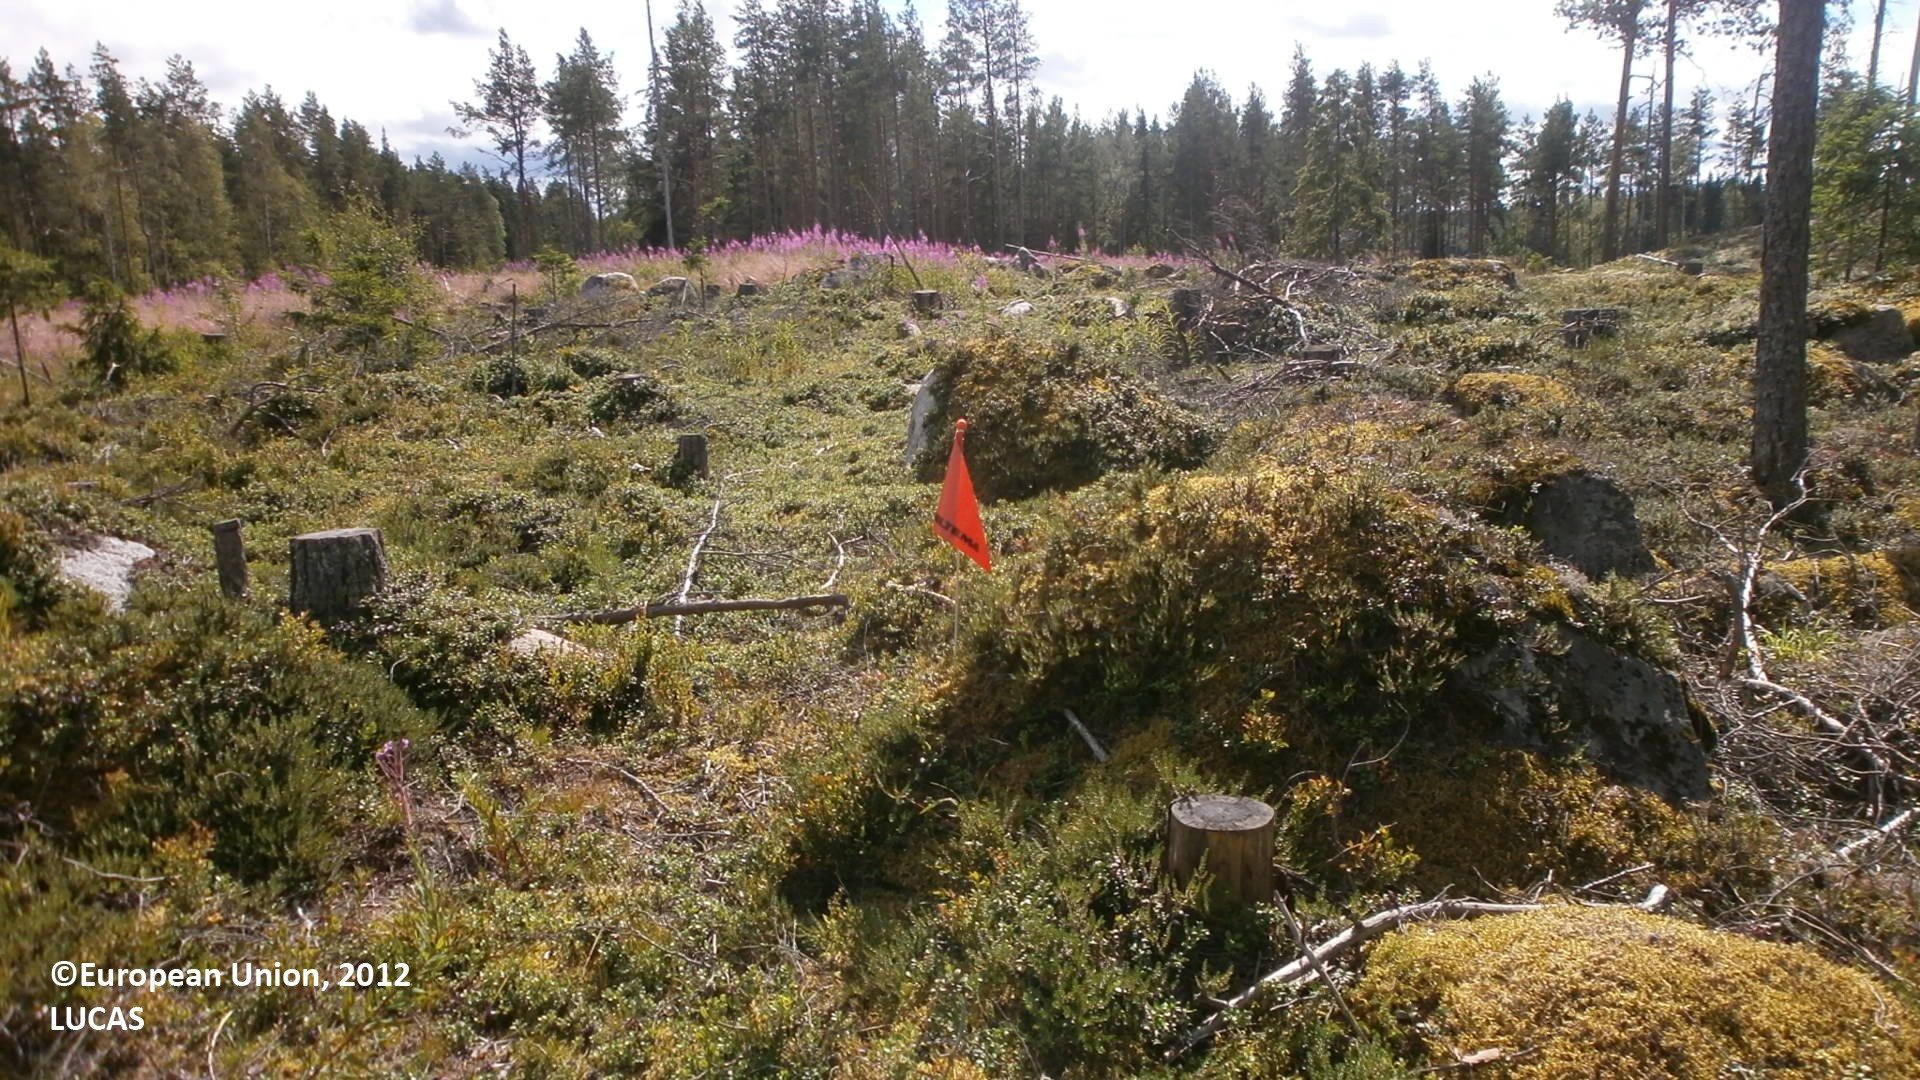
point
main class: Shrubland
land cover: Shrubland without tree cover
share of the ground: > 75 %
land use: Forestry
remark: Clear cut
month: July
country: FI
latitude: 64.0204
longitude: 23.7075
